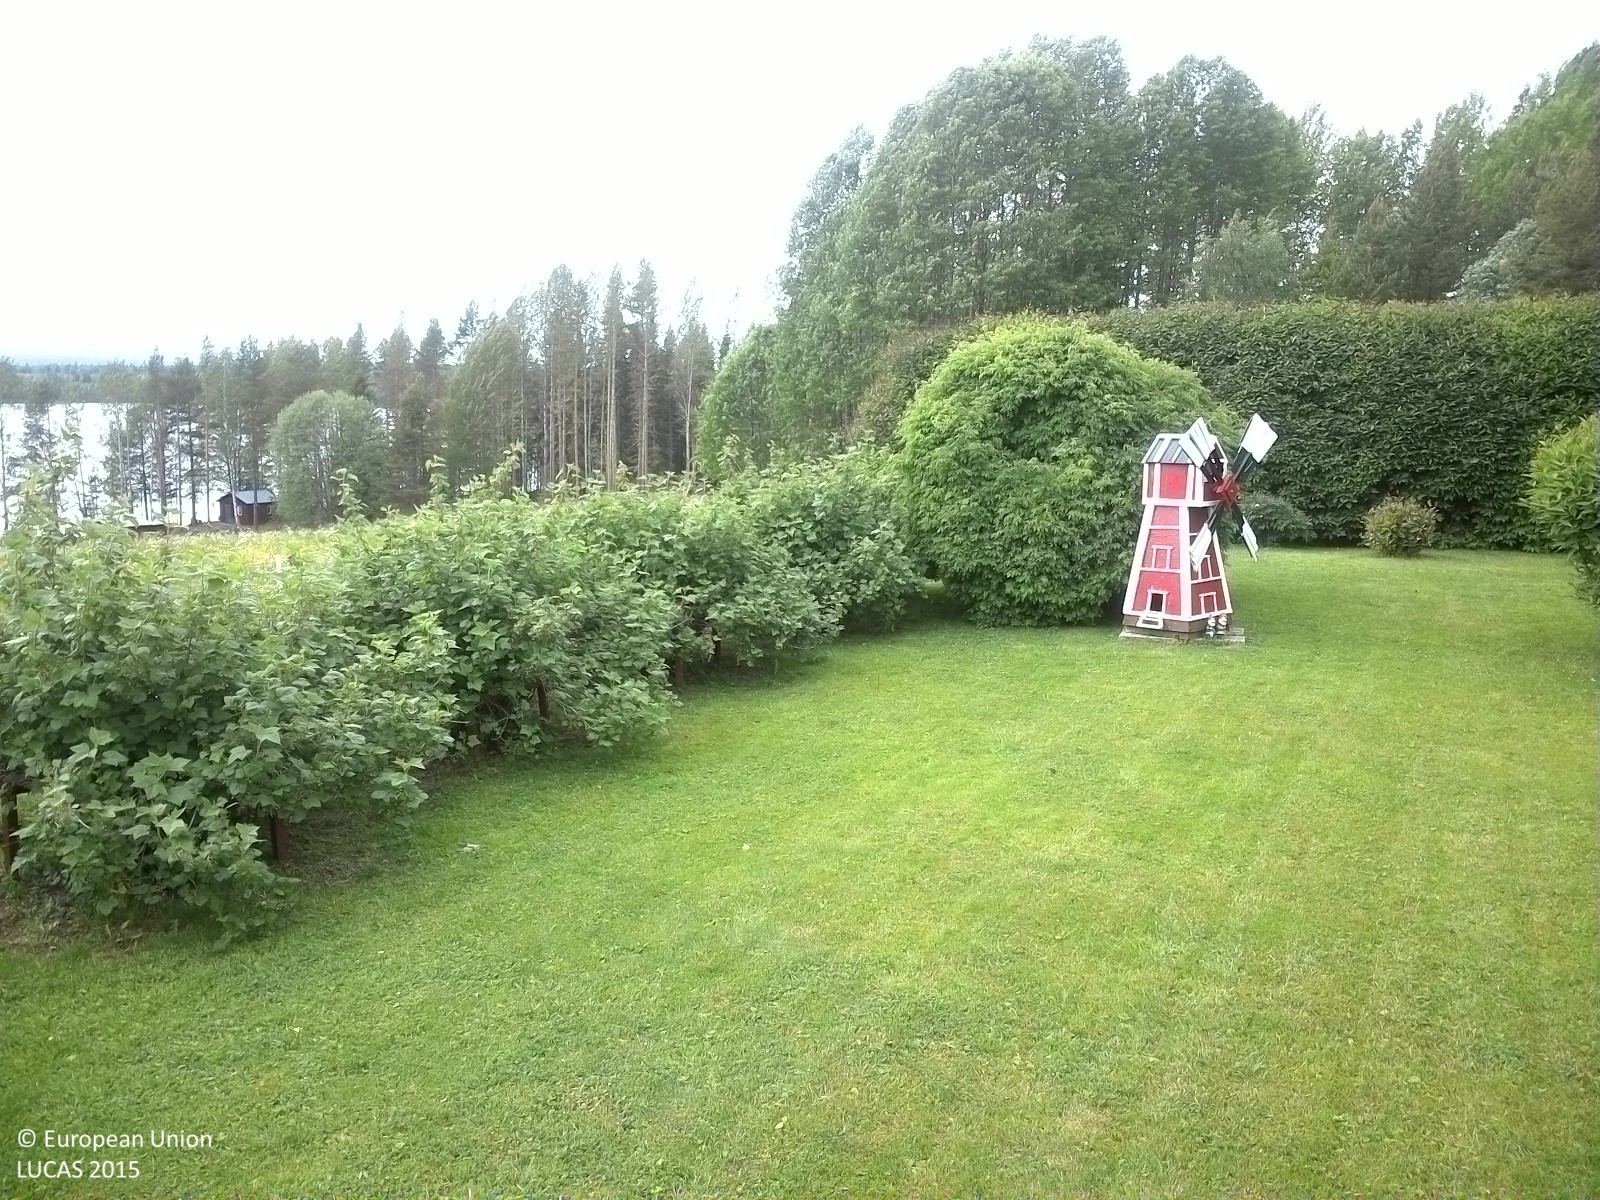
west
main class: Grassland
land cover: Grassland without tree/shrub cover
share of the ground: > 75 %
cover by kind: herbaceous plants 100 %
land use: Residential
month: July
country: SE
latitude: 63.6407
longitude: 14.7205
